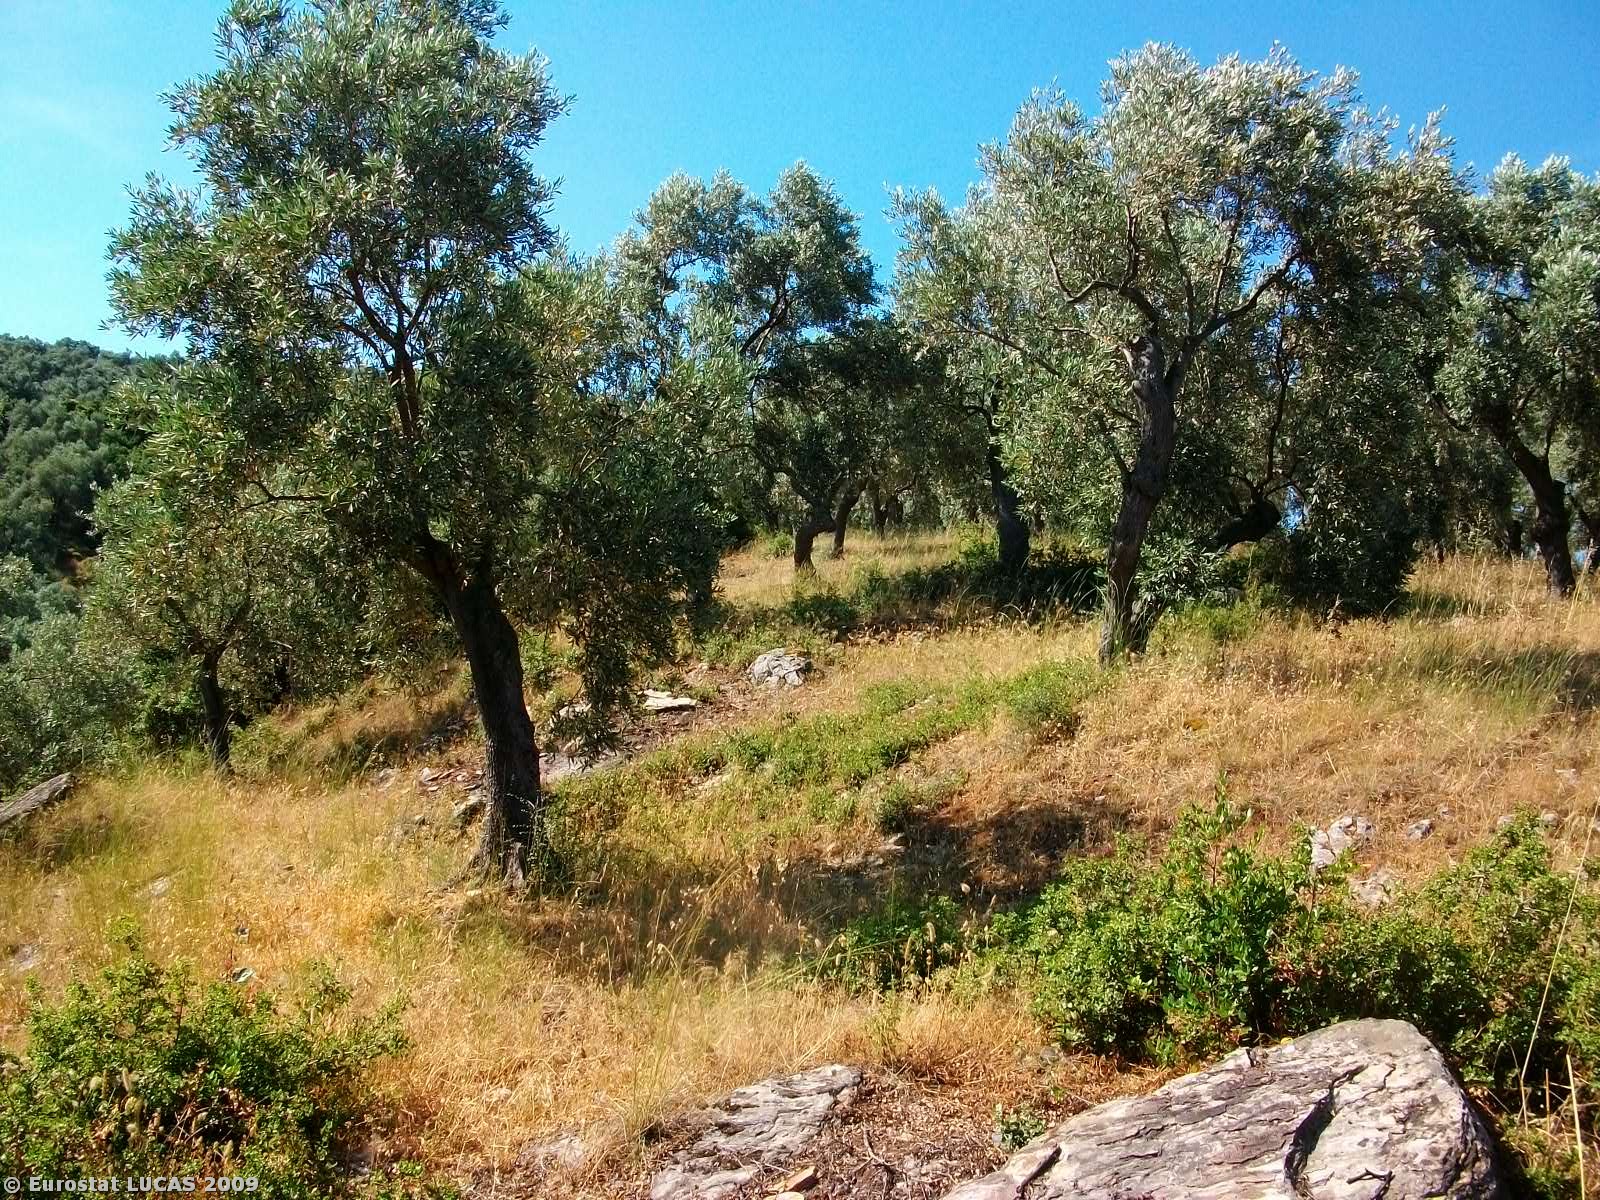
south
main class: Cropland
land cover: Olive groves
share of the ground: 50 - 75 %
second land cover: Grassland with sparse tree/shrub cover
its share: > 75 %
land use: Agriculture (excluding fallow land and kitchen gardens)
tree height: < 5 m
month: June
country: GR
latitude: 39.1669
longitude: 23.2208
